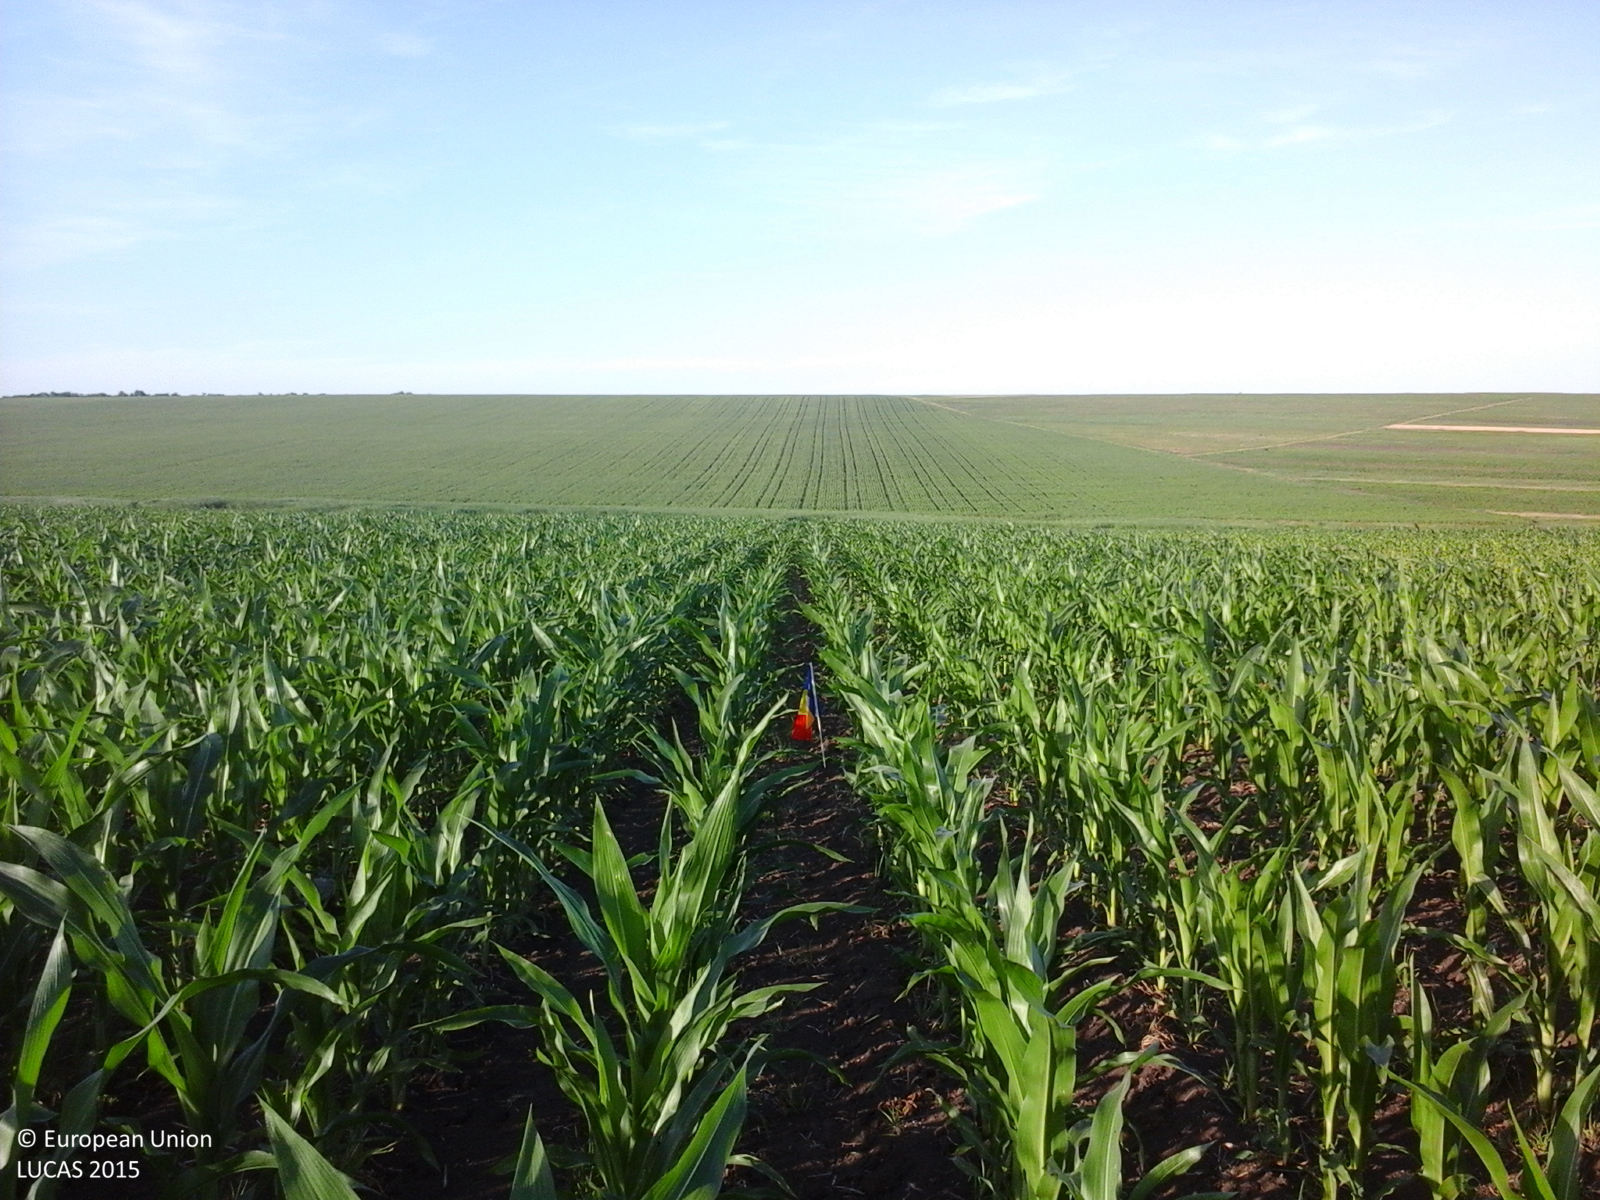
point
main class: Cropland
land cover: Maize
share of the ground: > 75 %
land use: Agriculture (excluding fallow land and kitchen gardens)
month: June
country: RO
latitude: 47.3405
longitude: 27.0582
